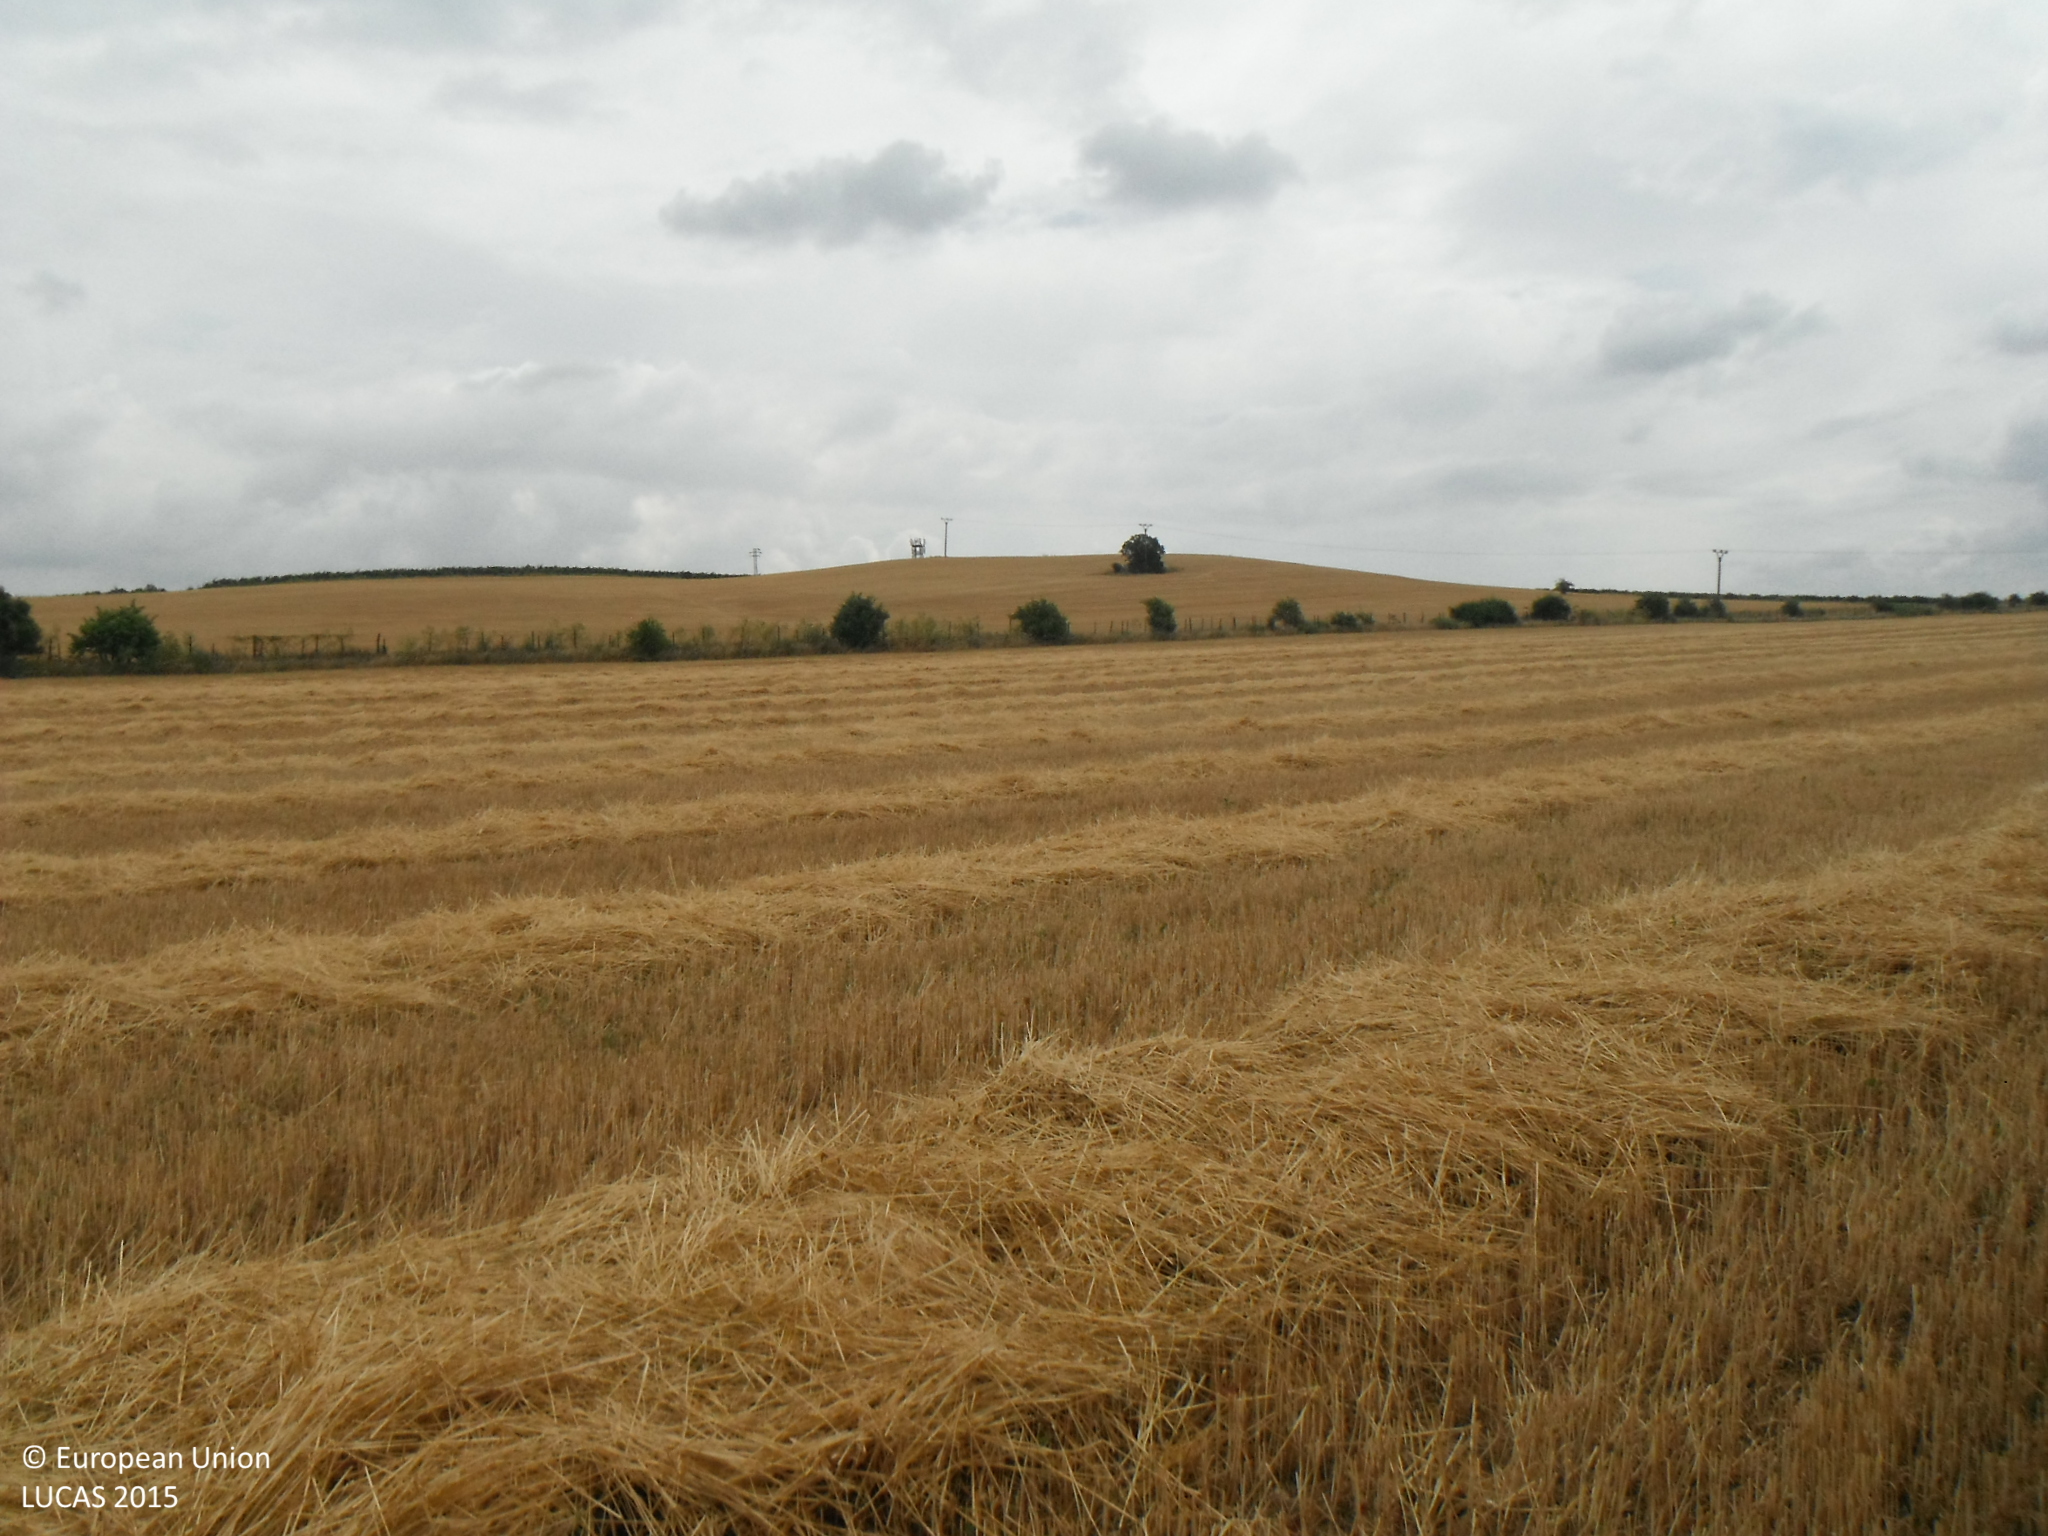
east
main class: Cropland
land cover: Common wheat
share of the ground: > 75 %
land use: Agriculture (excluding fallow land and kitchen gardens)
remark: Harvested field
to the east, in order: Common wheat; Shruby margins; Fences; Common wheat; Other bare soil; Common wheat
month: July
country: SK
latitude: 47.8589
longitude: 18.2605
